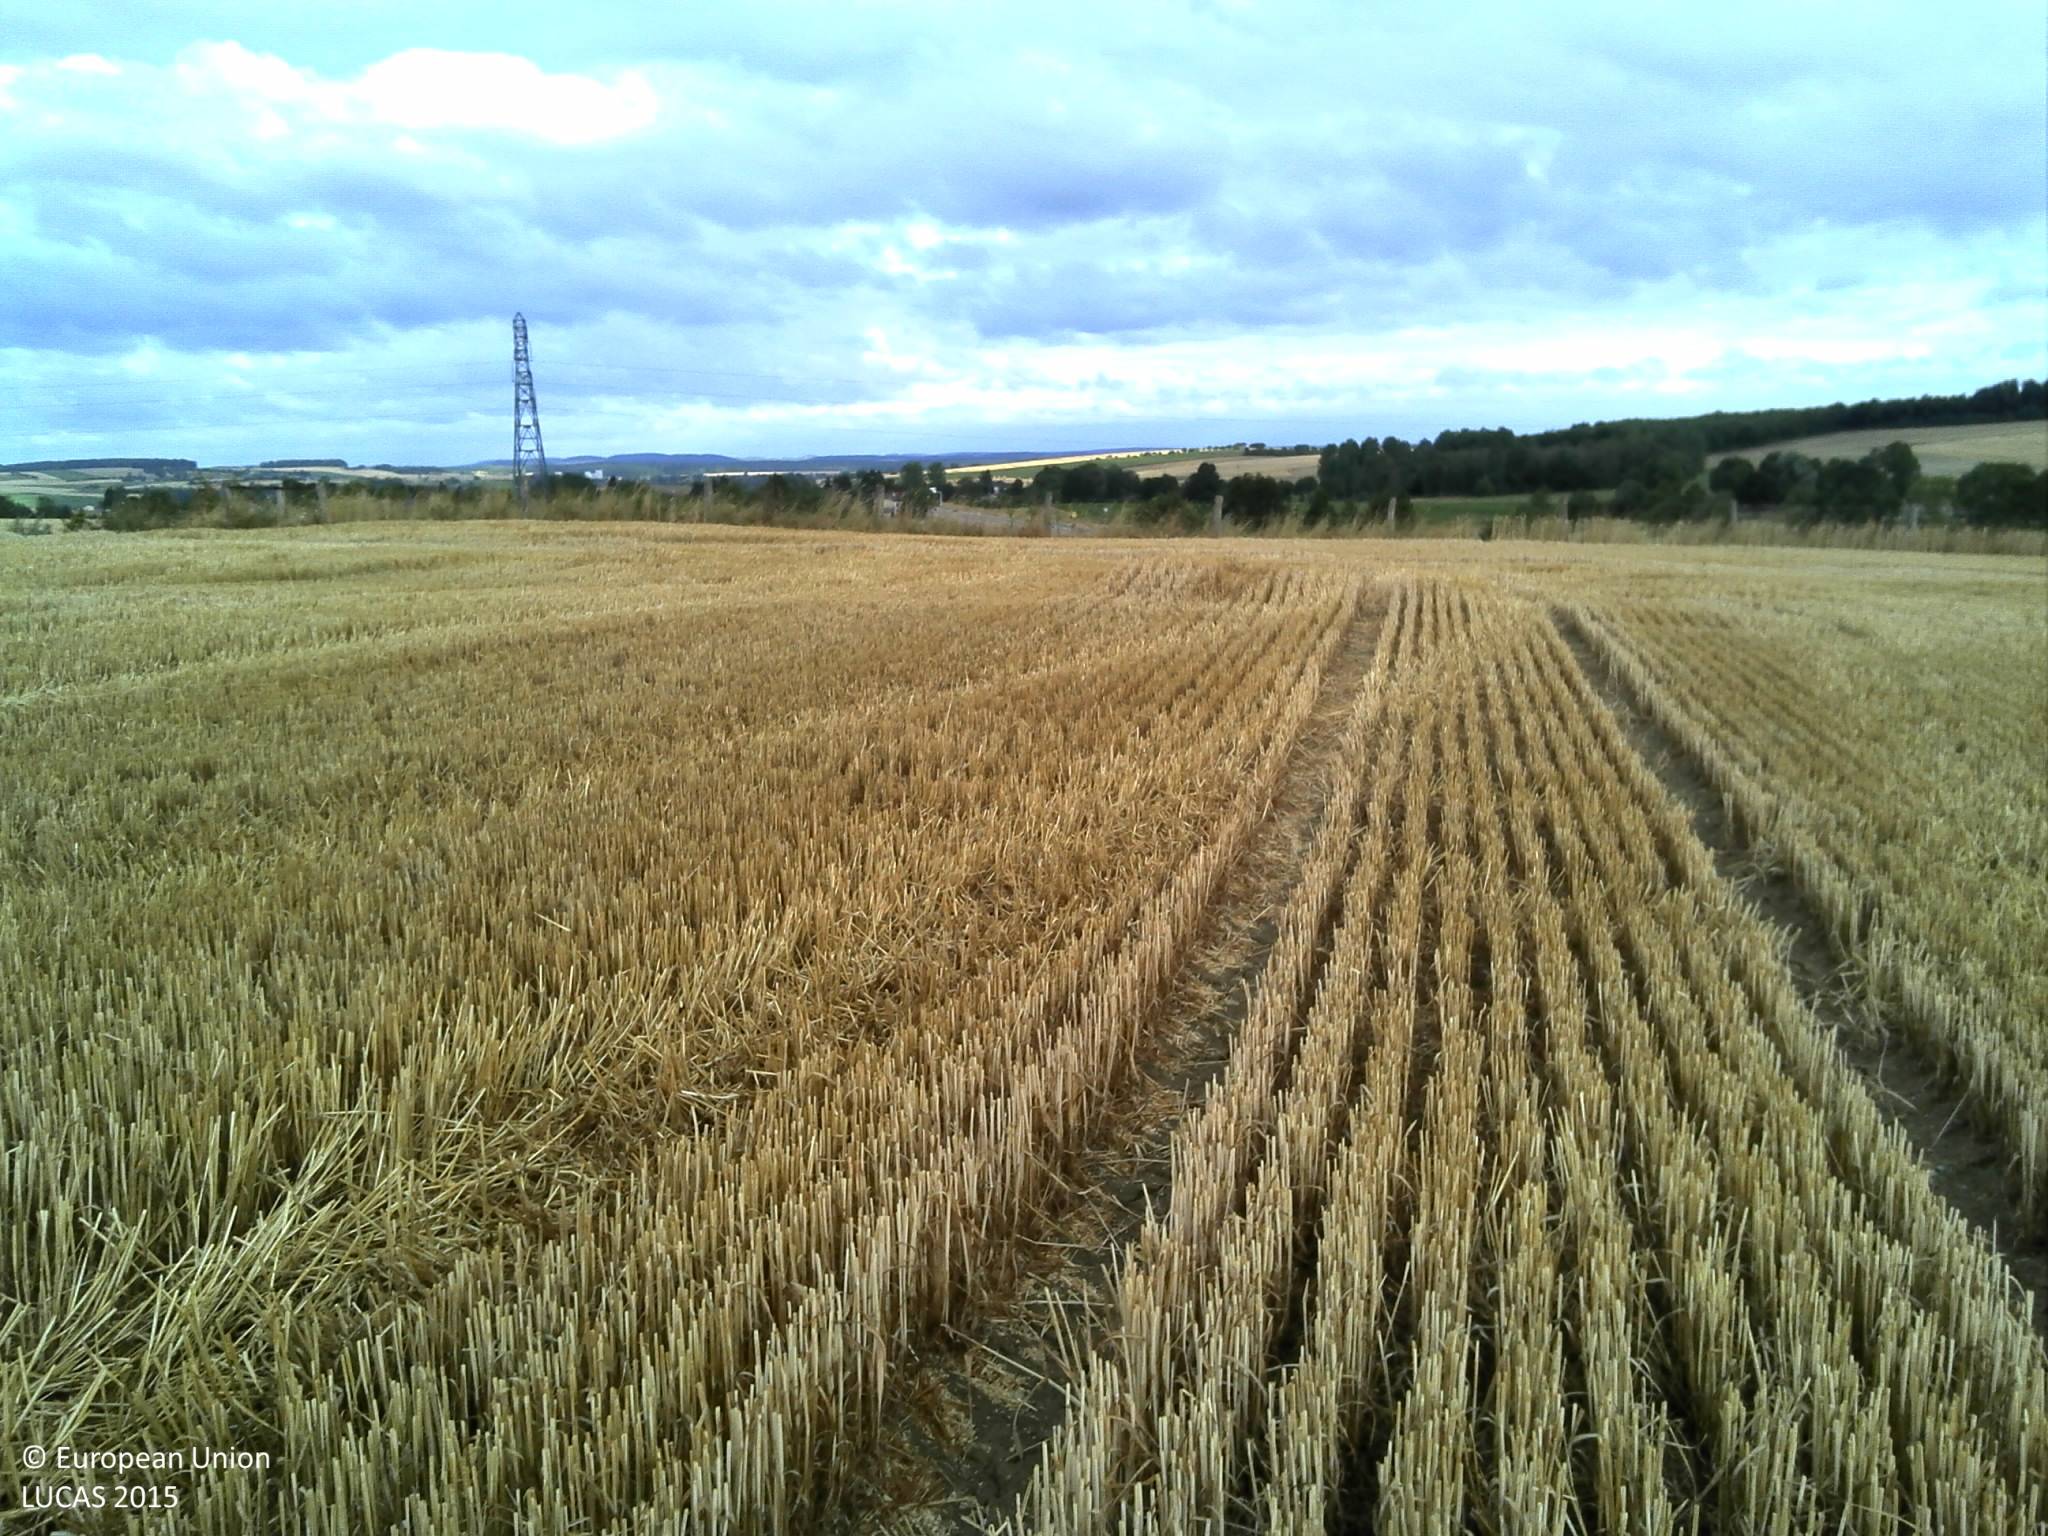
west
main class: Cropland
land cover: Common wheat
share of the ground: < 10 %
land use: Agriculture (excluding fallow land and kitchen gardens)
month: July
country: FR
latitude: 48.2155
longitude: 6.2995
